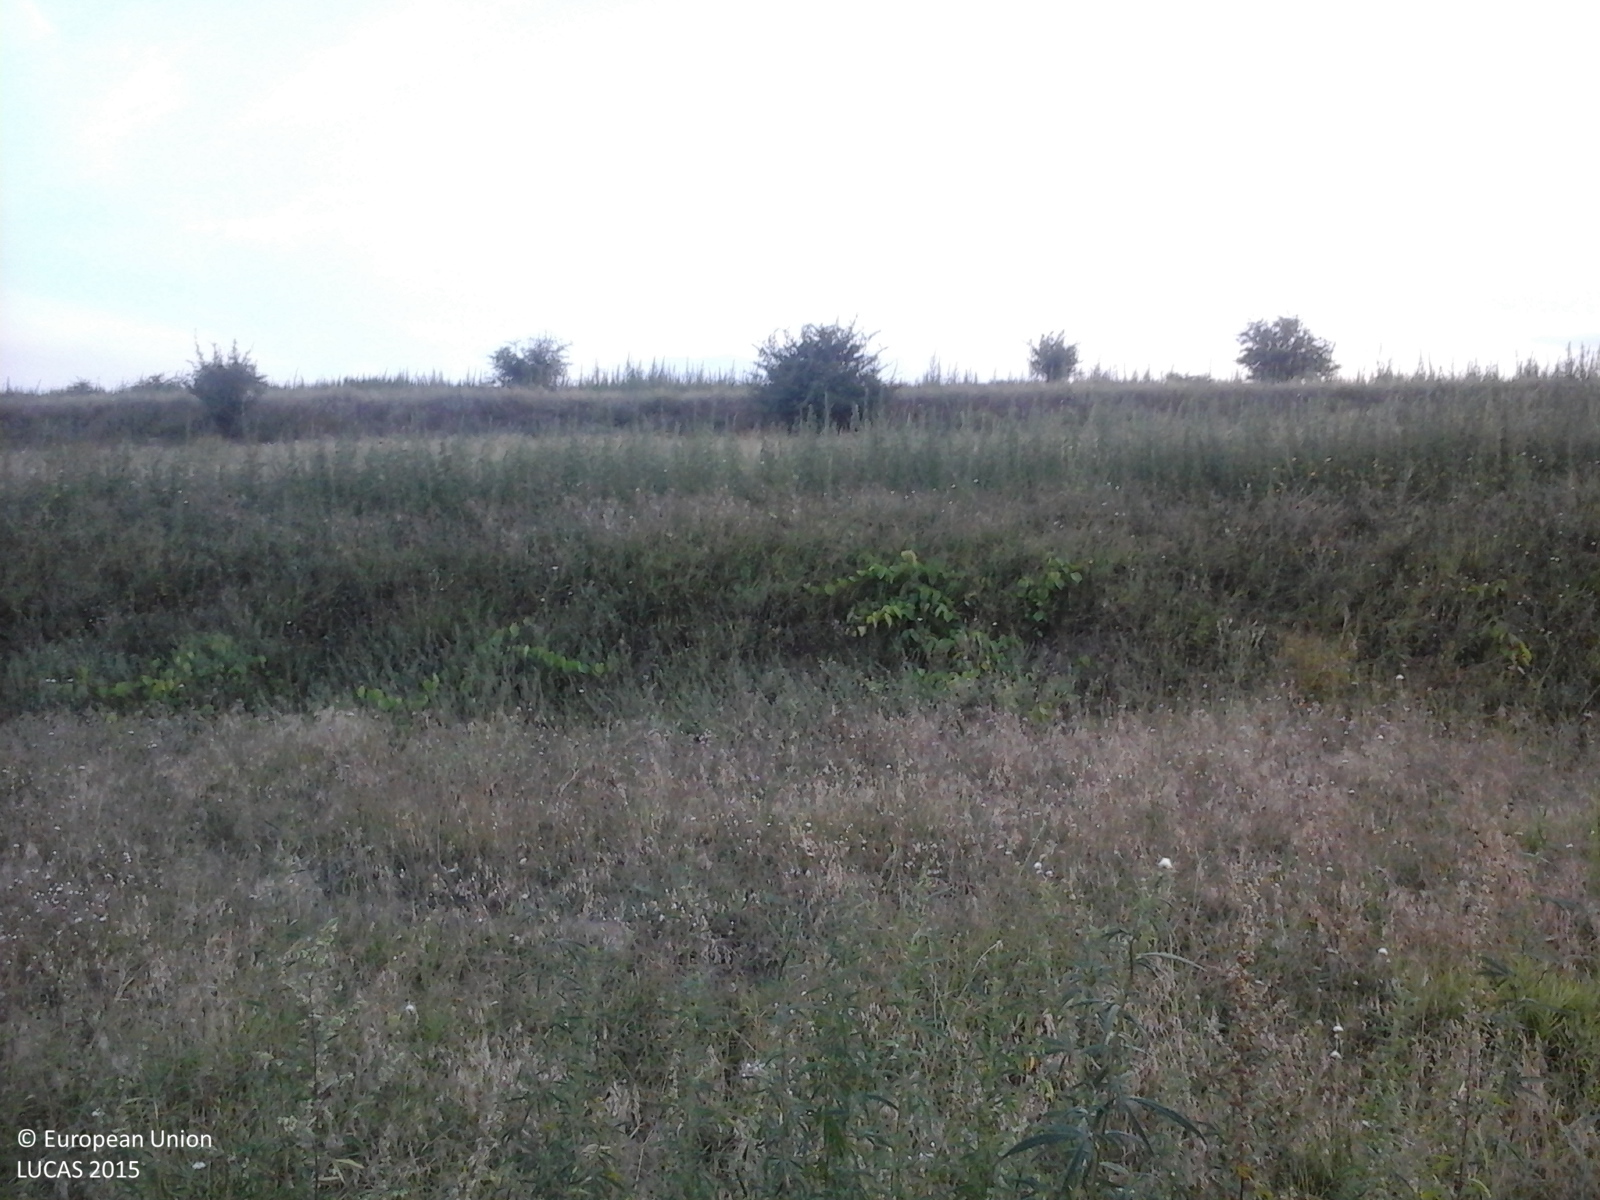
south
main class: Grassland
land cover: Spontaneously vegetated surfaces
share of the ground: > 75 %
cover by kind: herbaceous plants 100 %
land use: Fallow land
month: August
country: RO
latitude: 44.2542
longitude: 28.1058
